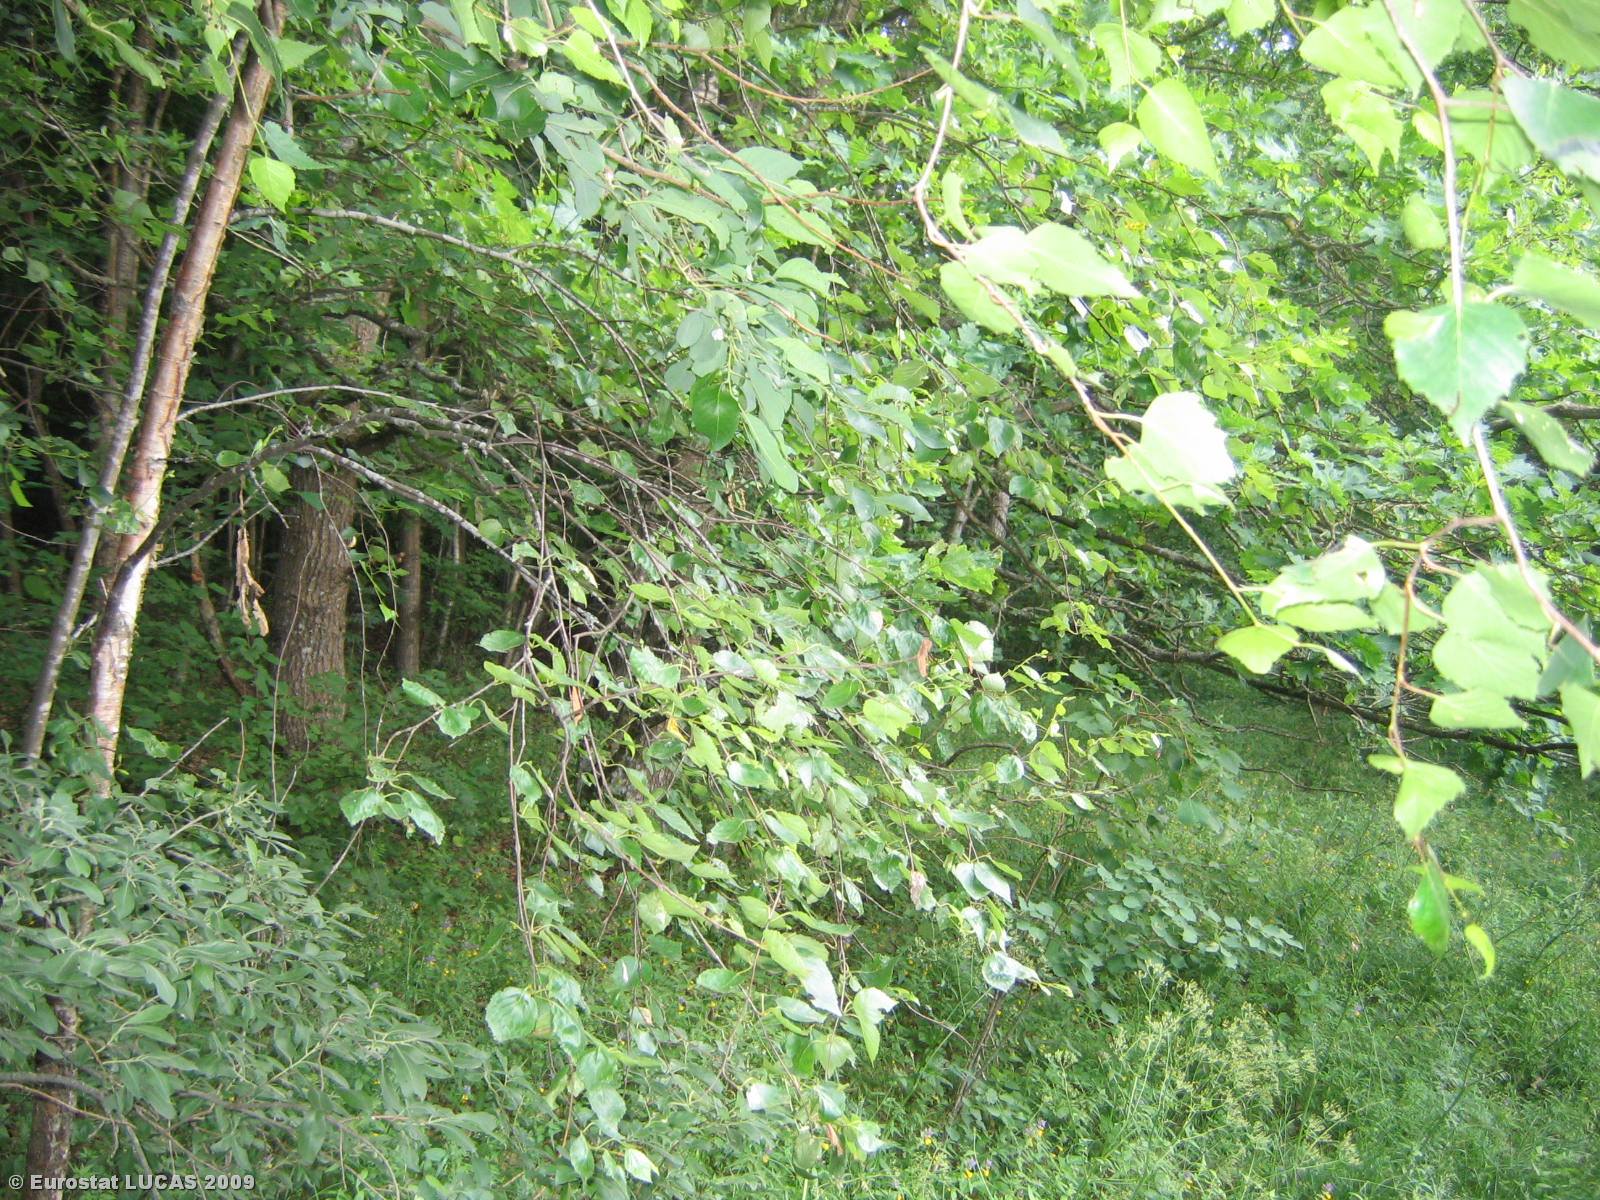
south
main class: Woodland
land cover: Broadleaved woodland
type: non-riverine alder, birch or aspen forest
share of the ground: > 75 %
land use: Forestry
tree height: > 5 m
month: July
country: LT
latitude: 55.4238
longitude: 22.7209
